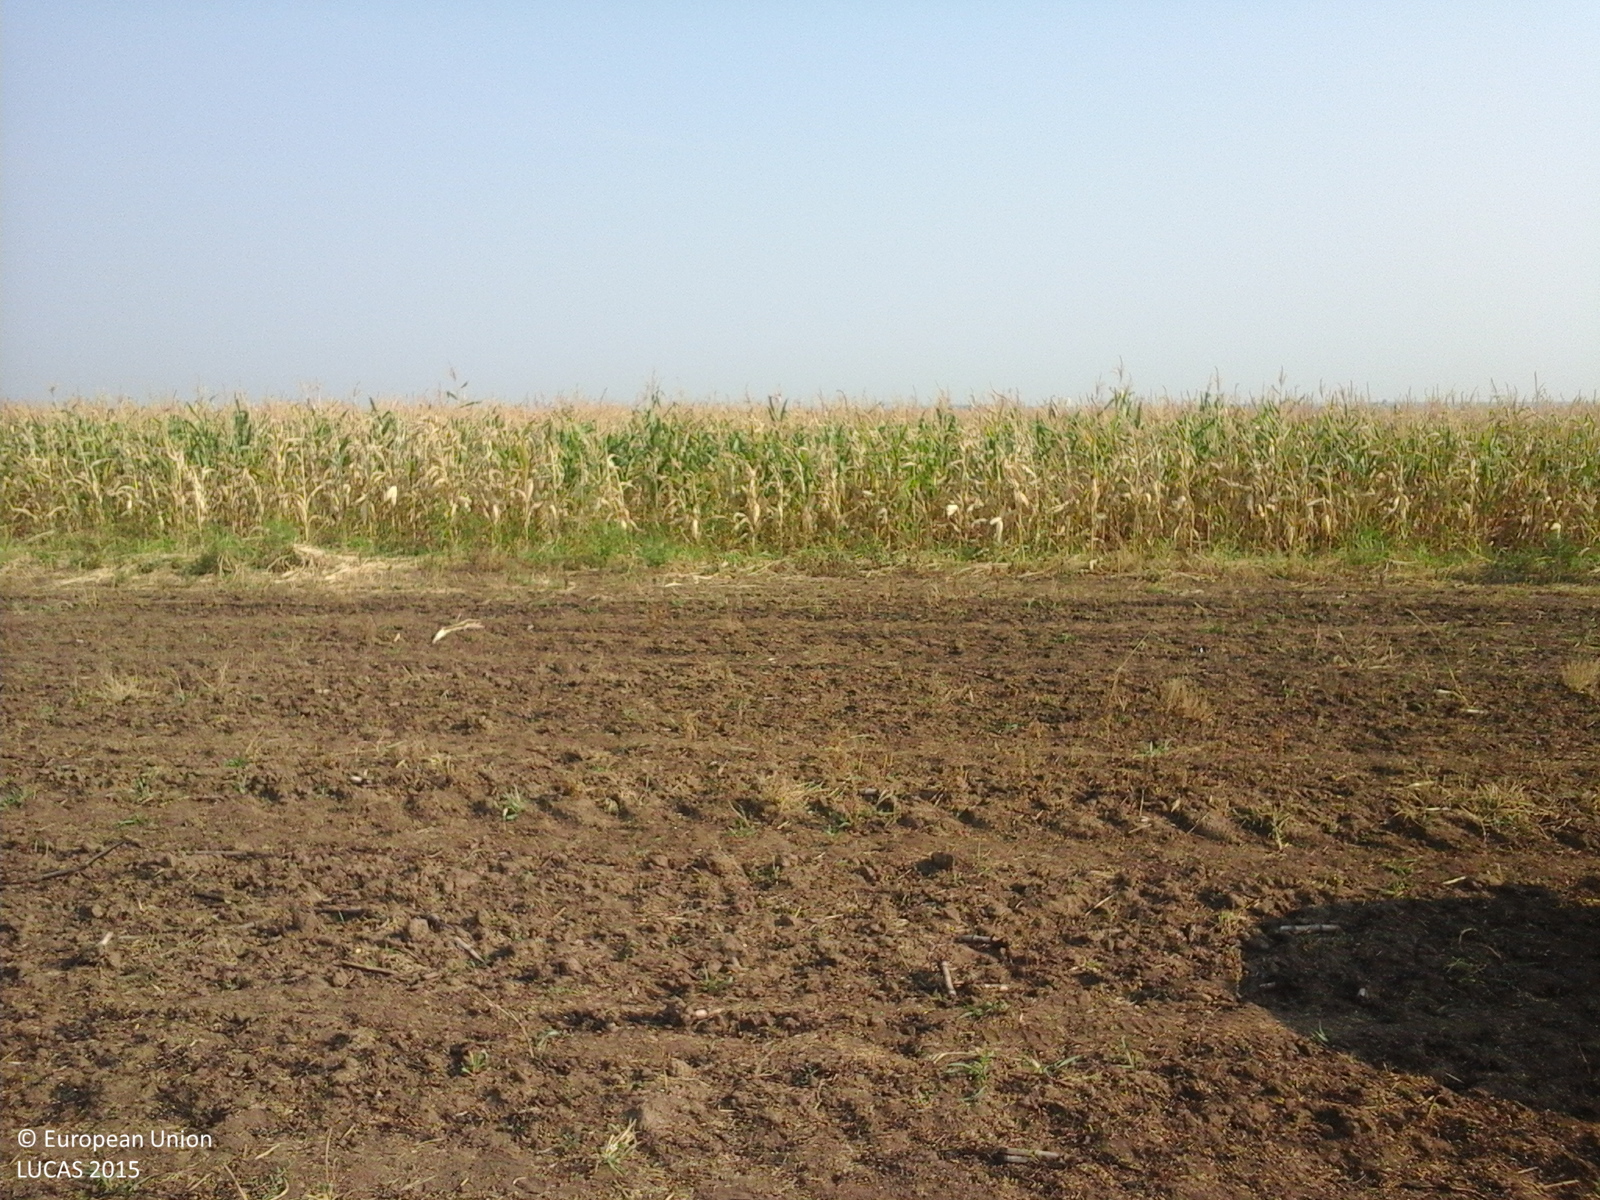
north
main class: Cropland
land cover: Common wheat
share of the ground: < 10 %
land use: Agriculture (excluding fallow land and kitchen gardens)
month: August
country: RO
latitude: 44.1578
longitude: 22.9335
